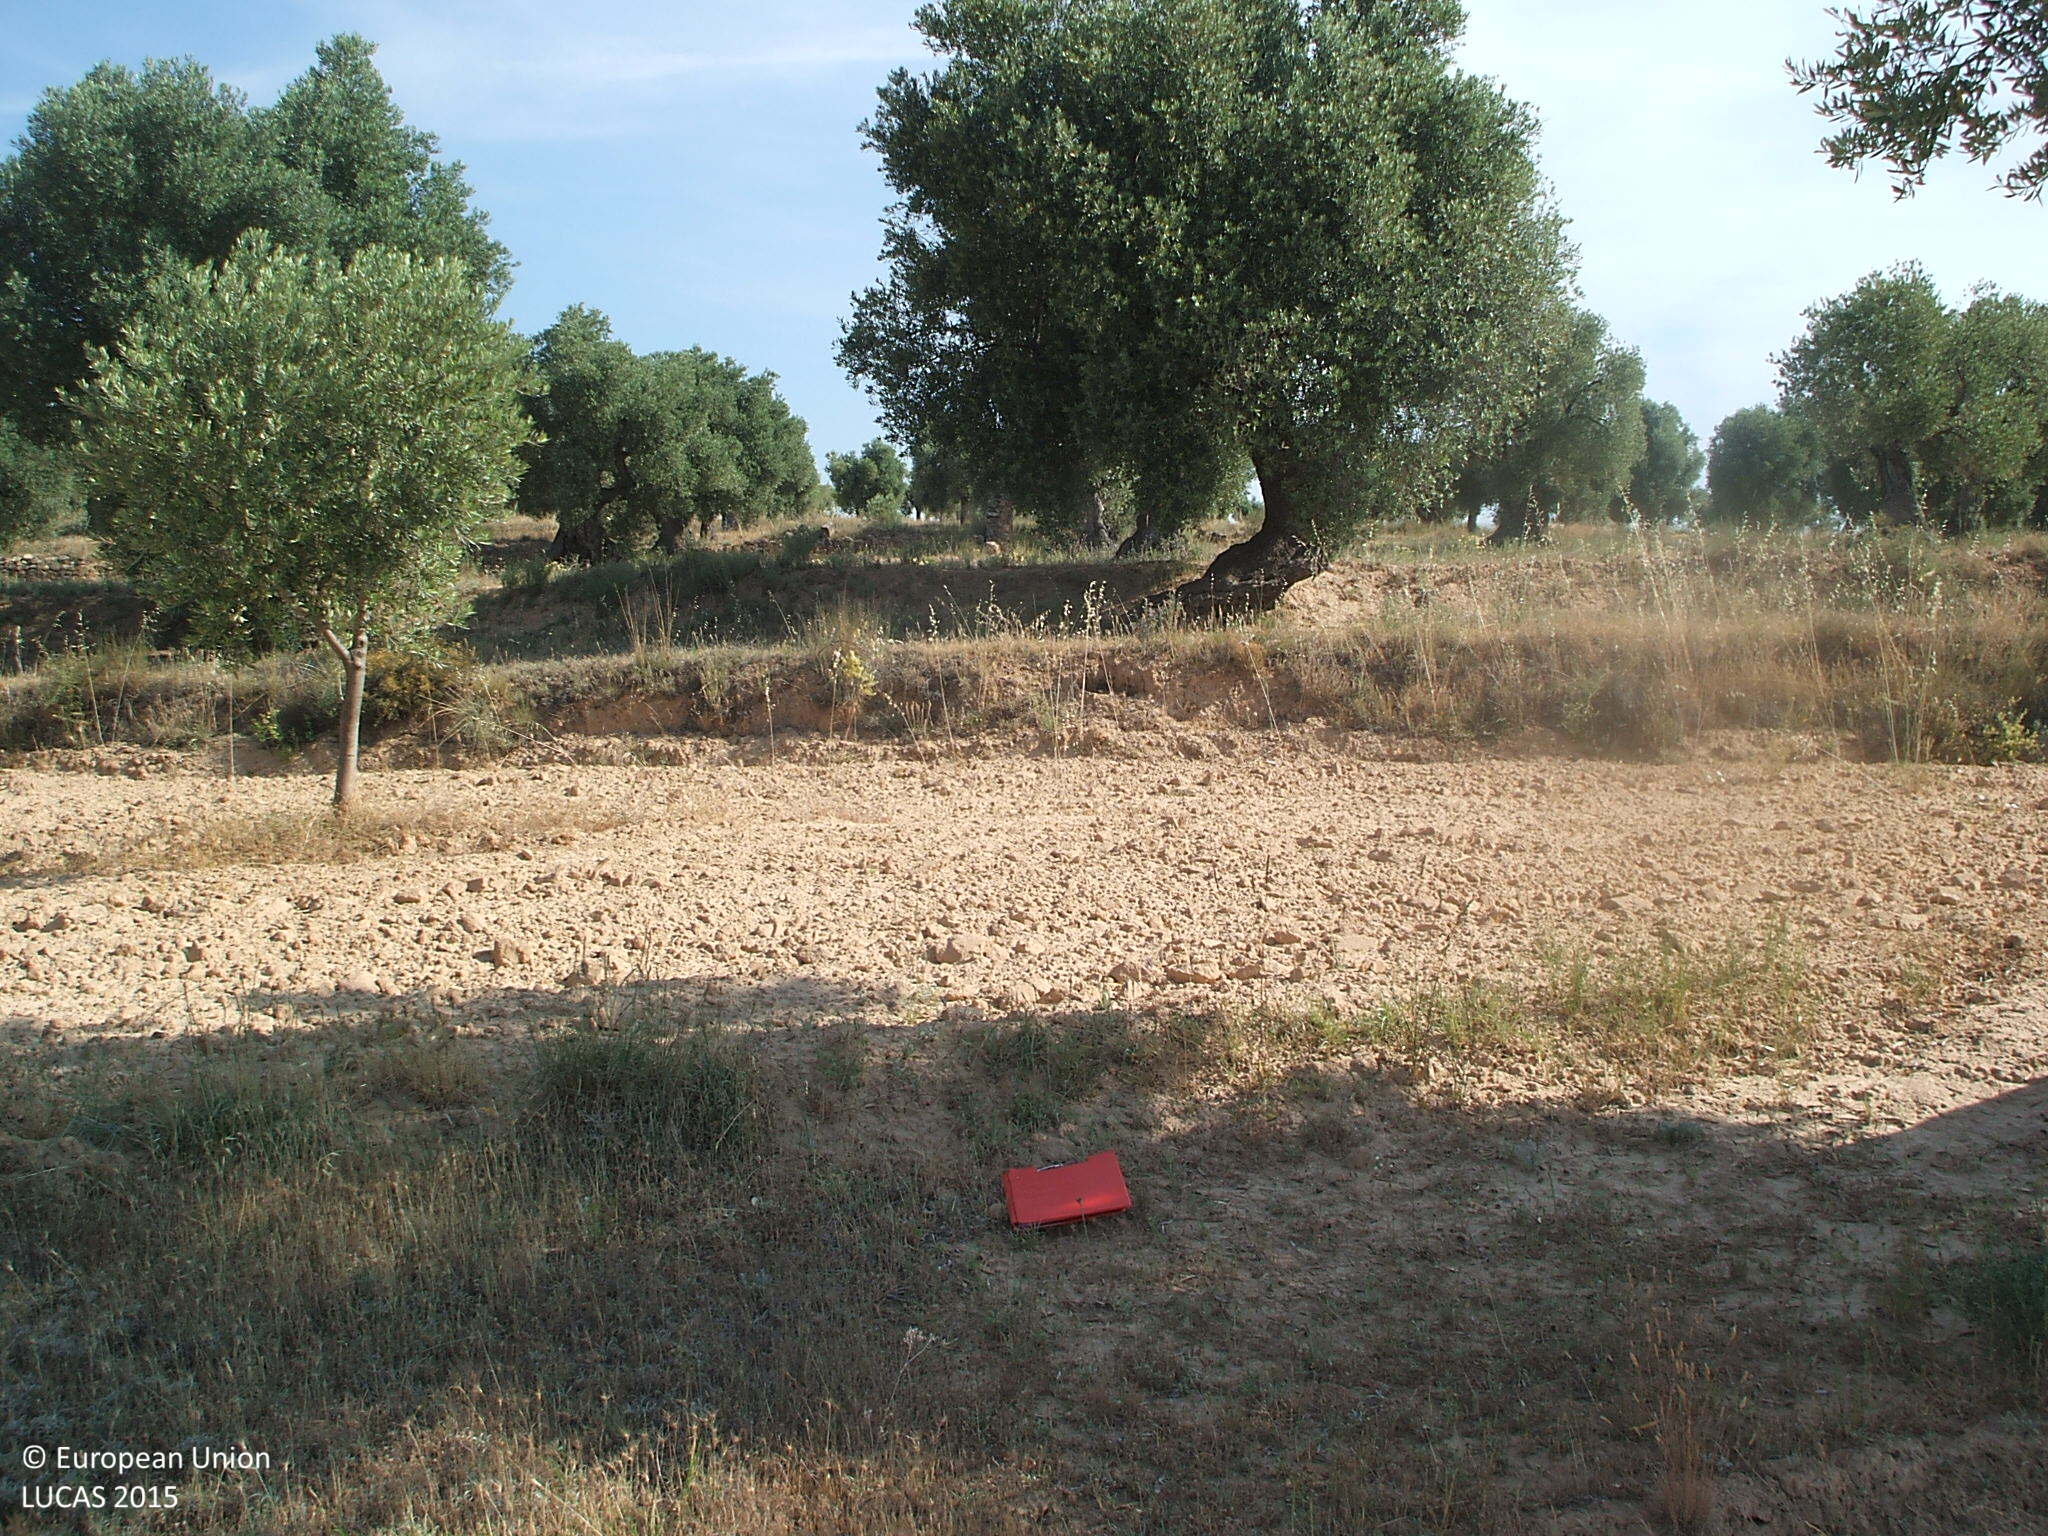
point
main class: Cropland
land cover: Olive groves
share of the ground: 10 - 25 %
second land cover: Other bare soil
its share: > 75 %
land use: Agriculture (excluding fallow land and kitchen gardens)
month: June
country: ES
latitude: 41.0452
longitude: 0.1516
